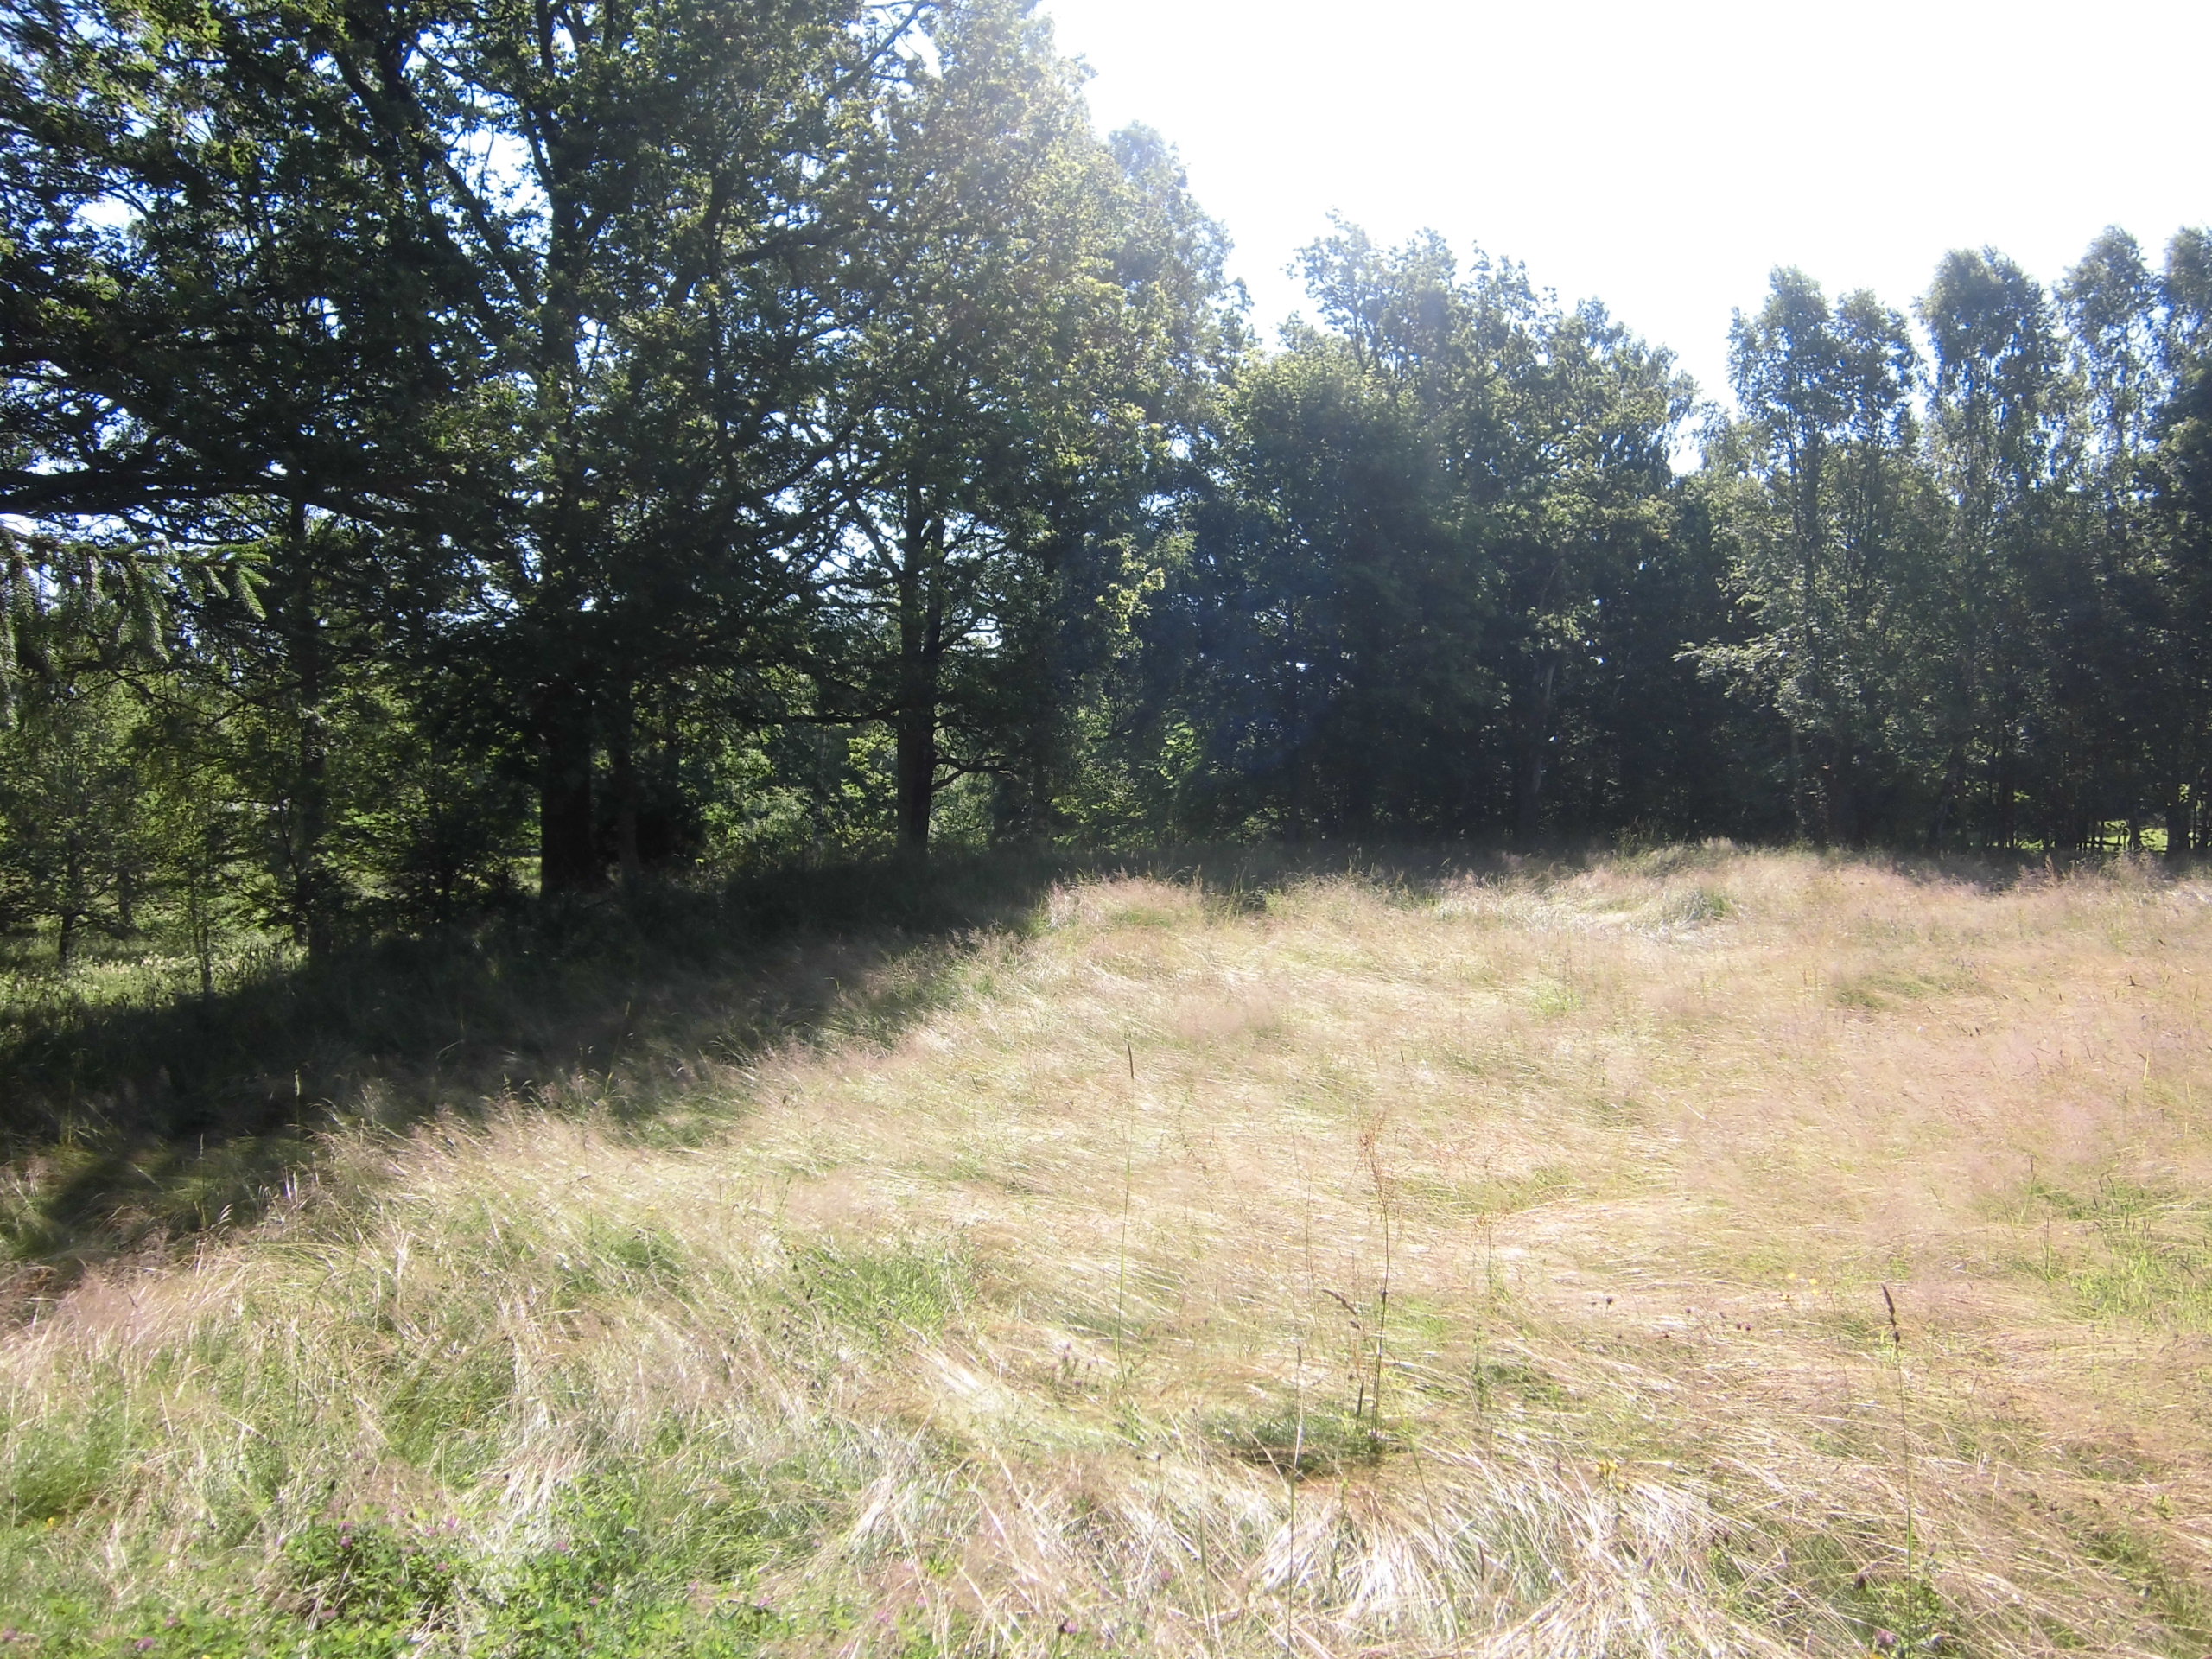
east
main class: Grassland
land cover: Grassland without tree/shrub cover
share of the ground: > 75 %
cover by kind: herbaceous plants 100 %
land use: Agriculture (excluding fallow land and kitchen gardens)
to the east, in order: Grassland without tree/shrub cover; Broadleaved woodland; Ditches and canals; Broadleaved woodland; Grassland with sparse tree/shrub cover; Single bushes/trees; Grassland with sparse tree/shrub cover; Electric lines; Grassland with sparse tree/shrub cover; Fences; Paved roads, cycling and walking lanes; Broadleaved woodland; Dry stone walls; Fences; Broadleaved woodland; Dry stone walls; Groves; Grassland with sparse tree/shrub cover; Broadleaved woodland
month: July
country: SE
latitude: 57.2947
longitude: 15.5232
